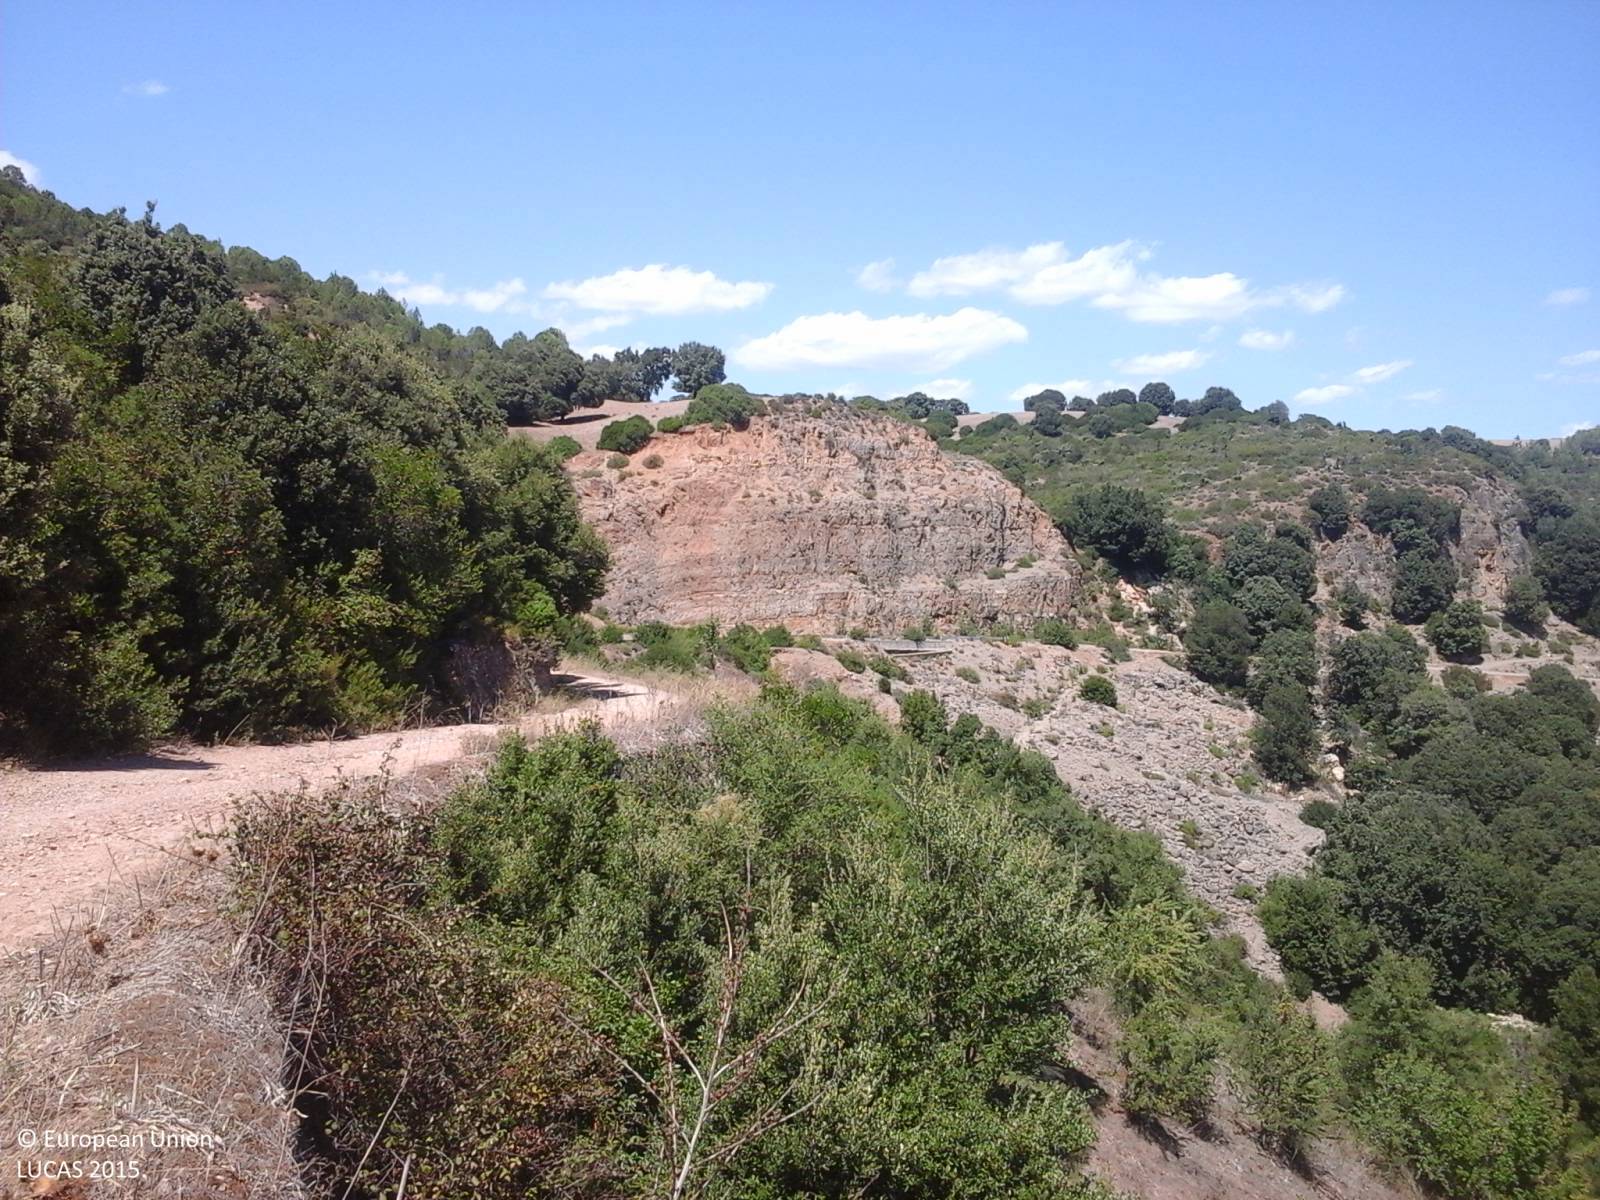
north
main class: Shrubland
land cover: Shrubland without tree cover
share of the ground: > 75 %
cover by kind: shrubs 100 %
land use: Semi-natural and natural areas not in use
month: August
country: IT
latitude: 39.6496
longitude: 9.3627
